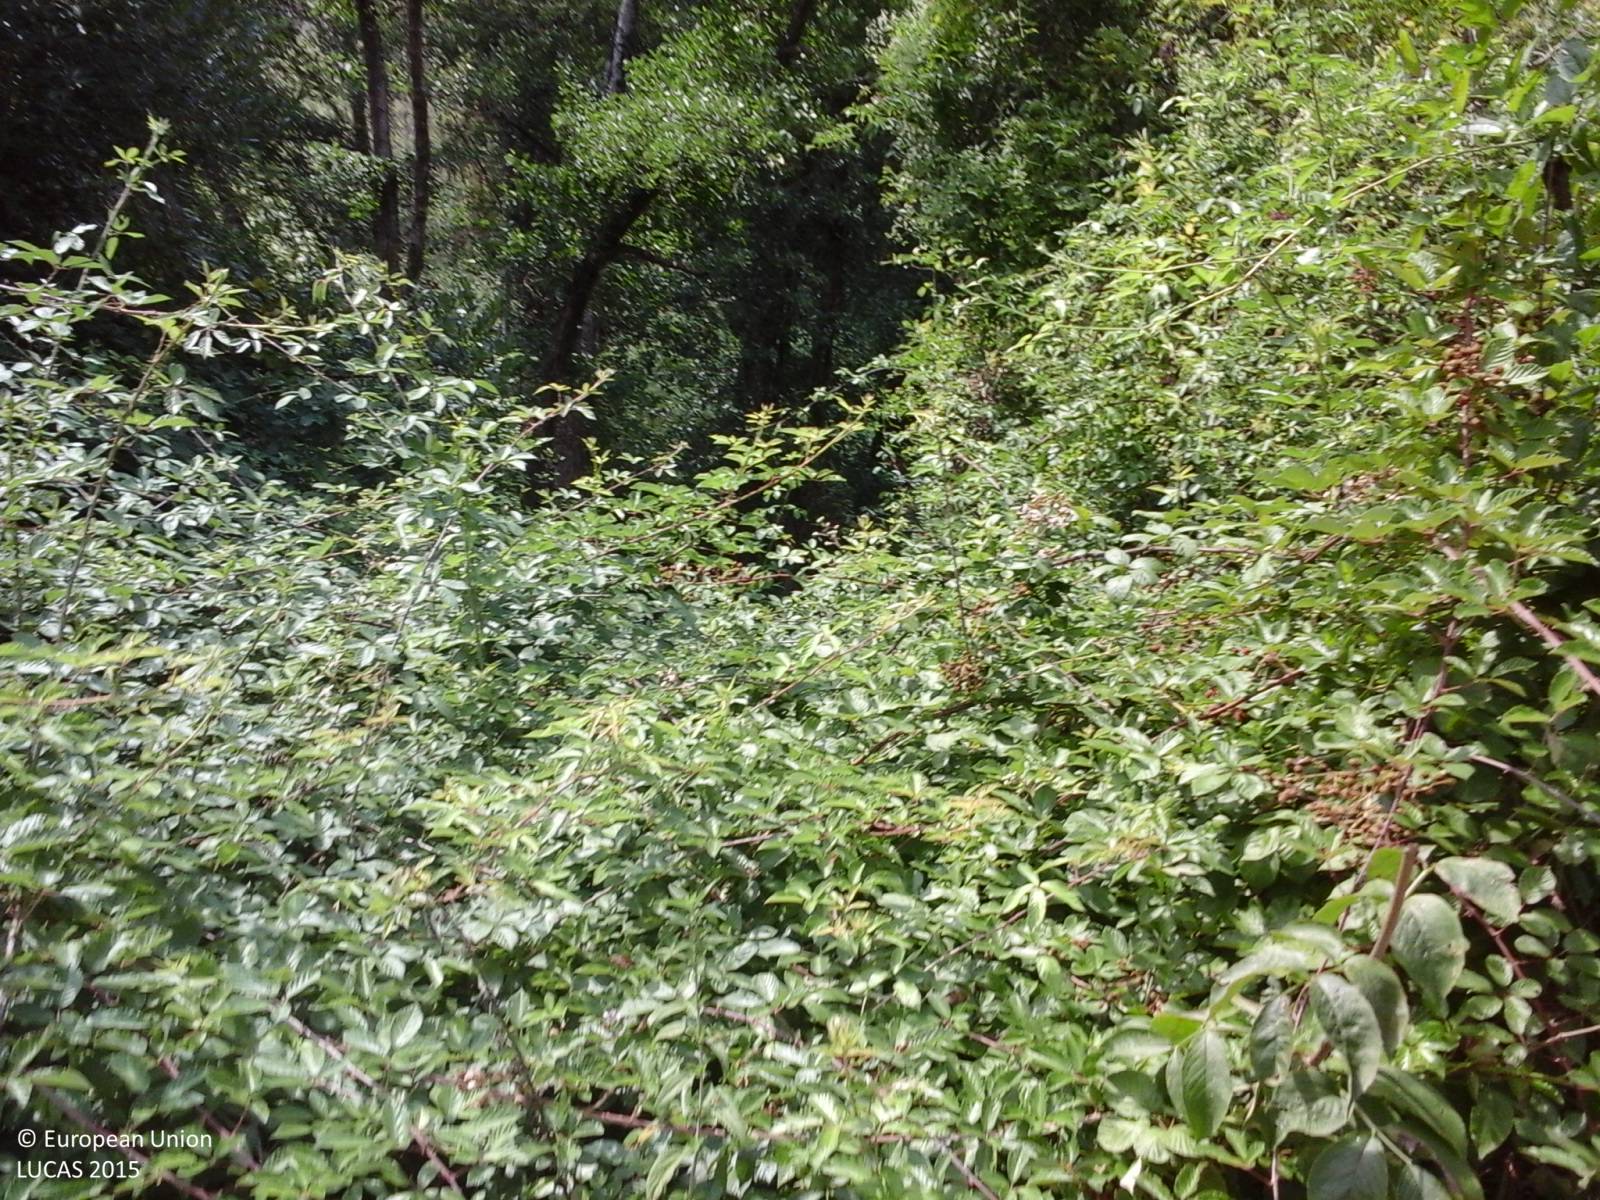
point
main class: Woodland
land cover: Broadleaved woodland
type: thermophilous deciduous forest
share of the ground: > 75 %
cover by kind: broadleaved forest trees 70 %, shrubs 30 %
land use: Semi-natural and natural areas not in use
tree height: > 5 m
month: July
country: IT
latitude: 42.2232
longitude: 12.5957
